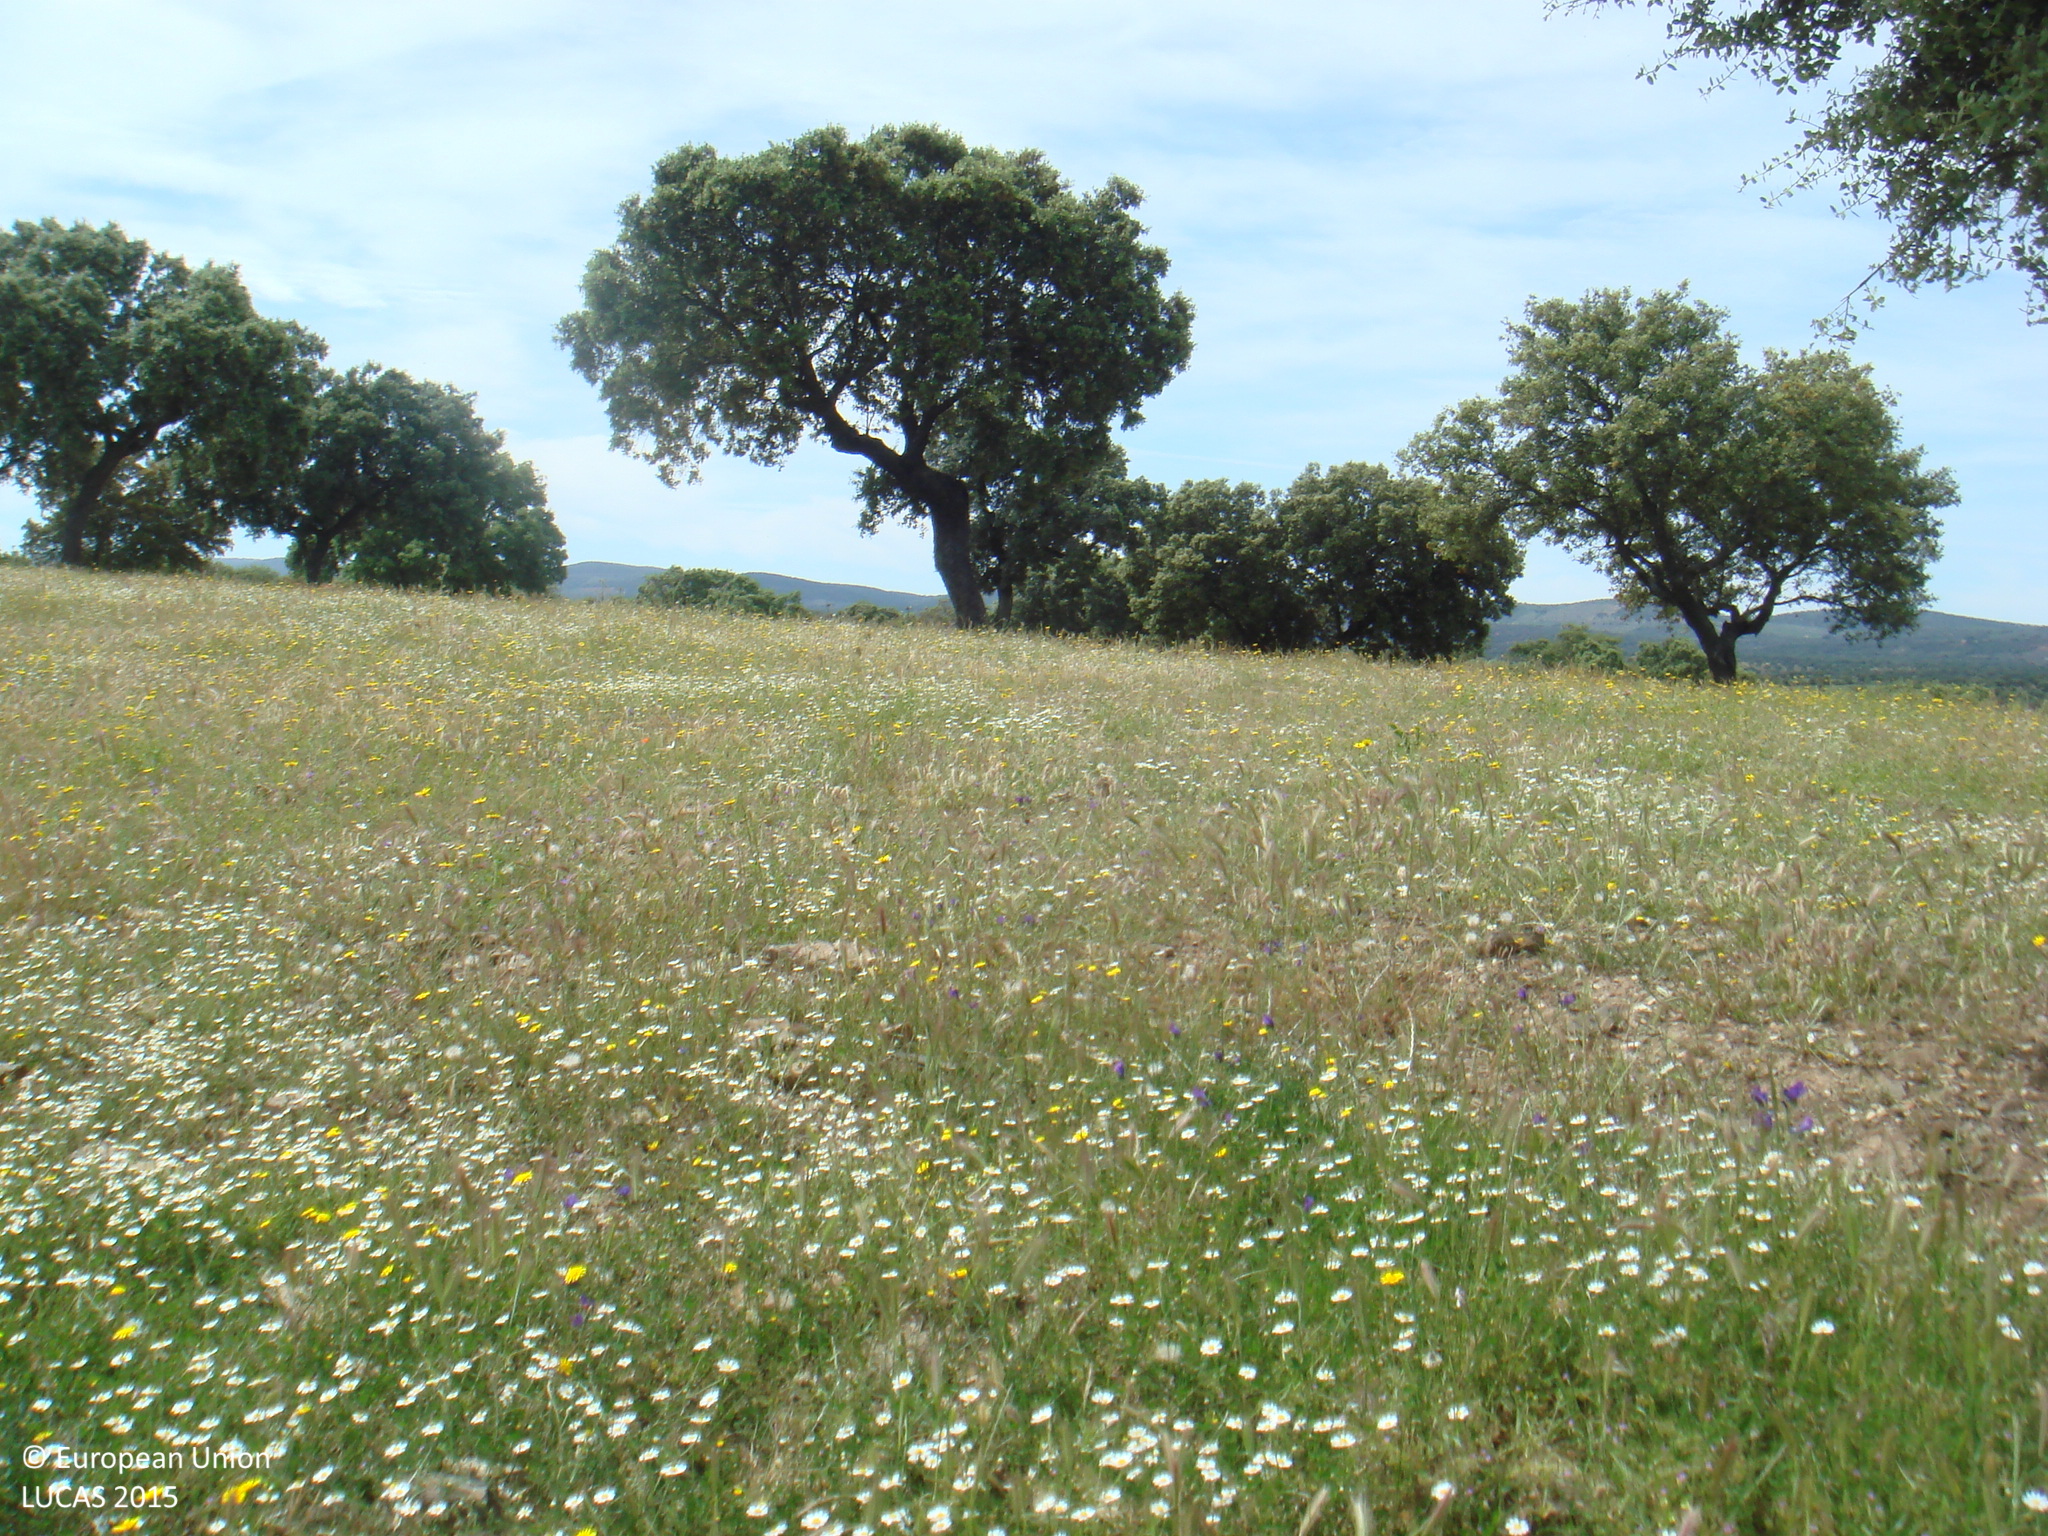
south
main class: Woodland
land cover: Broadleaved woodland
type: broadleaved evergreen forest
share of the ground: 25 - 50 %
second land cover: Grassland without tree/shrub cover
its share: > 75 %
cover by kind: herbaceous plants 70 %, broadleaved forest trees 30 %
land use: Forestry
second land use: Agriculture (excluding fallow land and kitchen gardens)
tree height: > 5 m
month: May
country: ES
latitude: 38.3775
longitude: -5.0796
